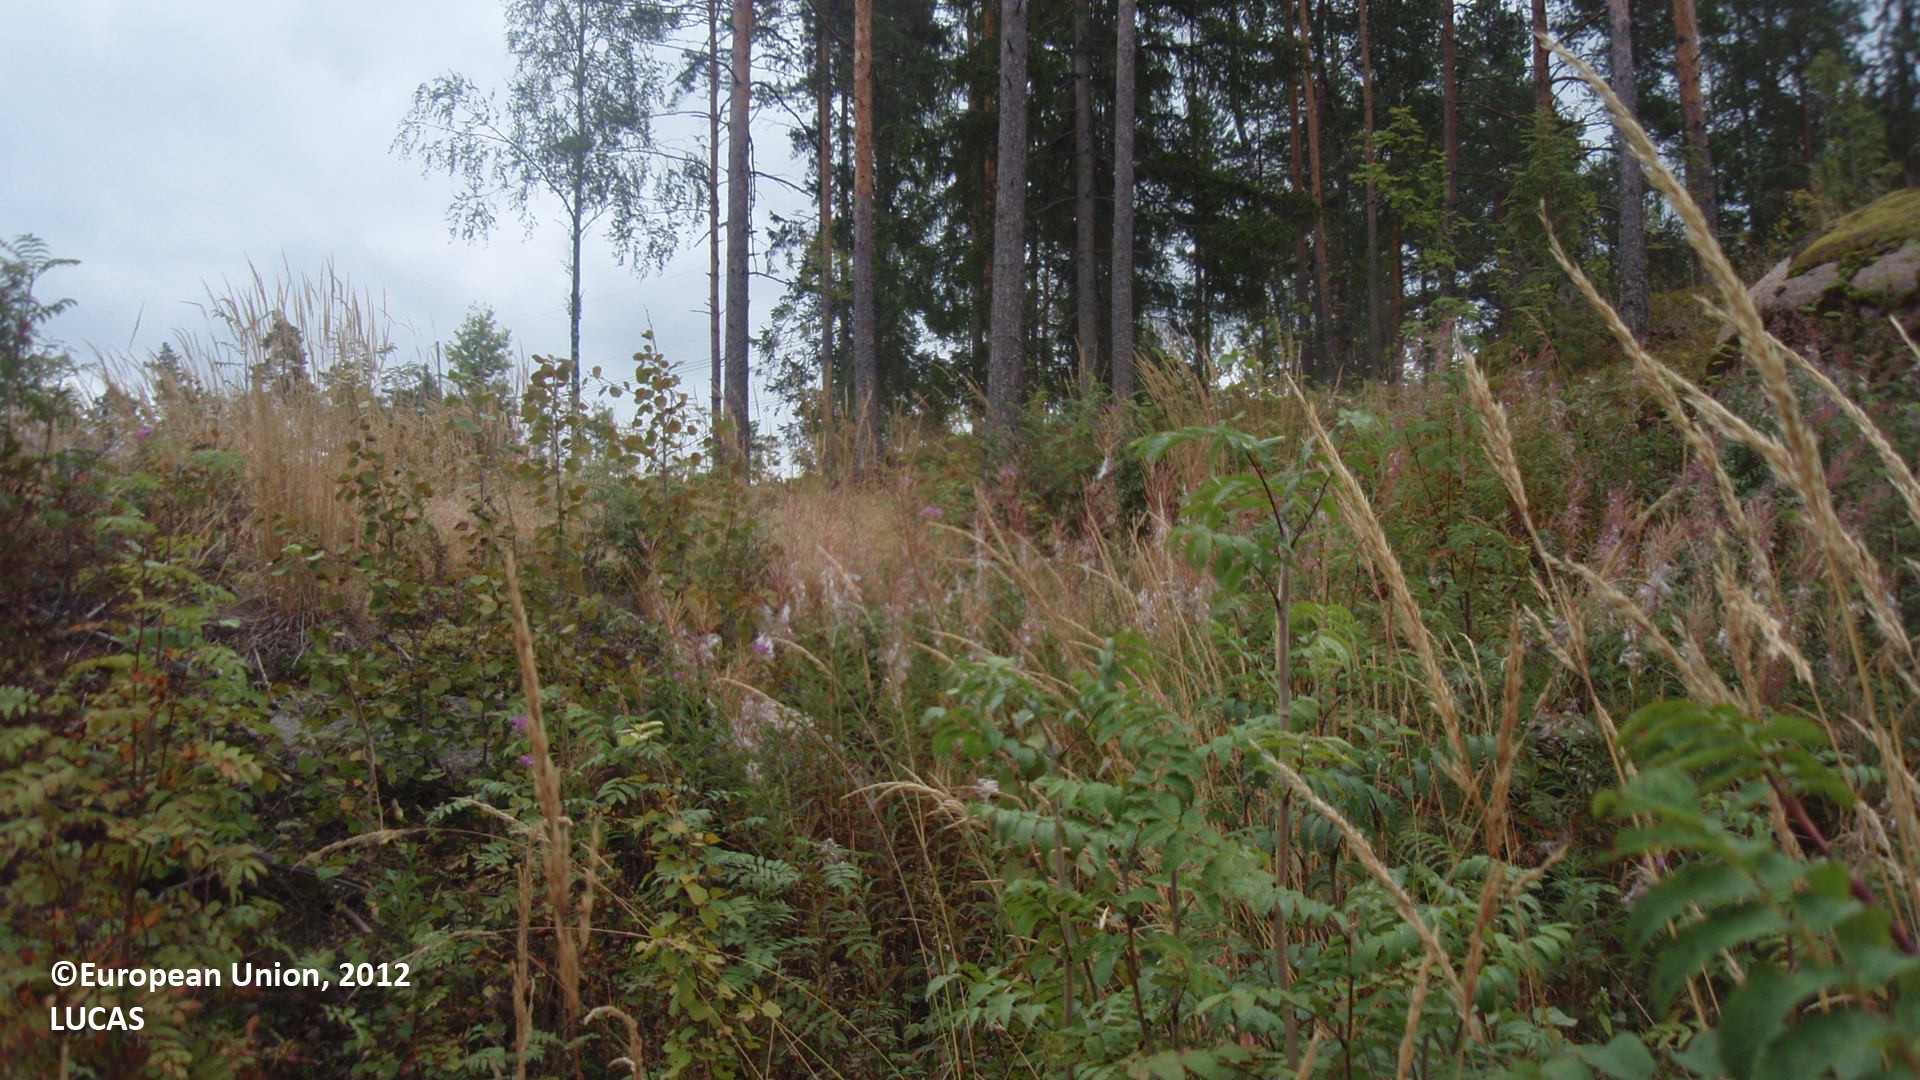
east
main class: Shrubland
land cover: Shrubland with sparse tree cover
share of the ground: > 75 %
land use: Forestry
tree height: > 5 m
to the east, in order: Shrubland with sparse tree cover; Pine dominated coniferous woodland; Shrubland with sparse tree cover; Electric lines; Shrubland with sparse tree cover
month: August
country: FI
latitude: 60.6596
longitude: 27.2468
